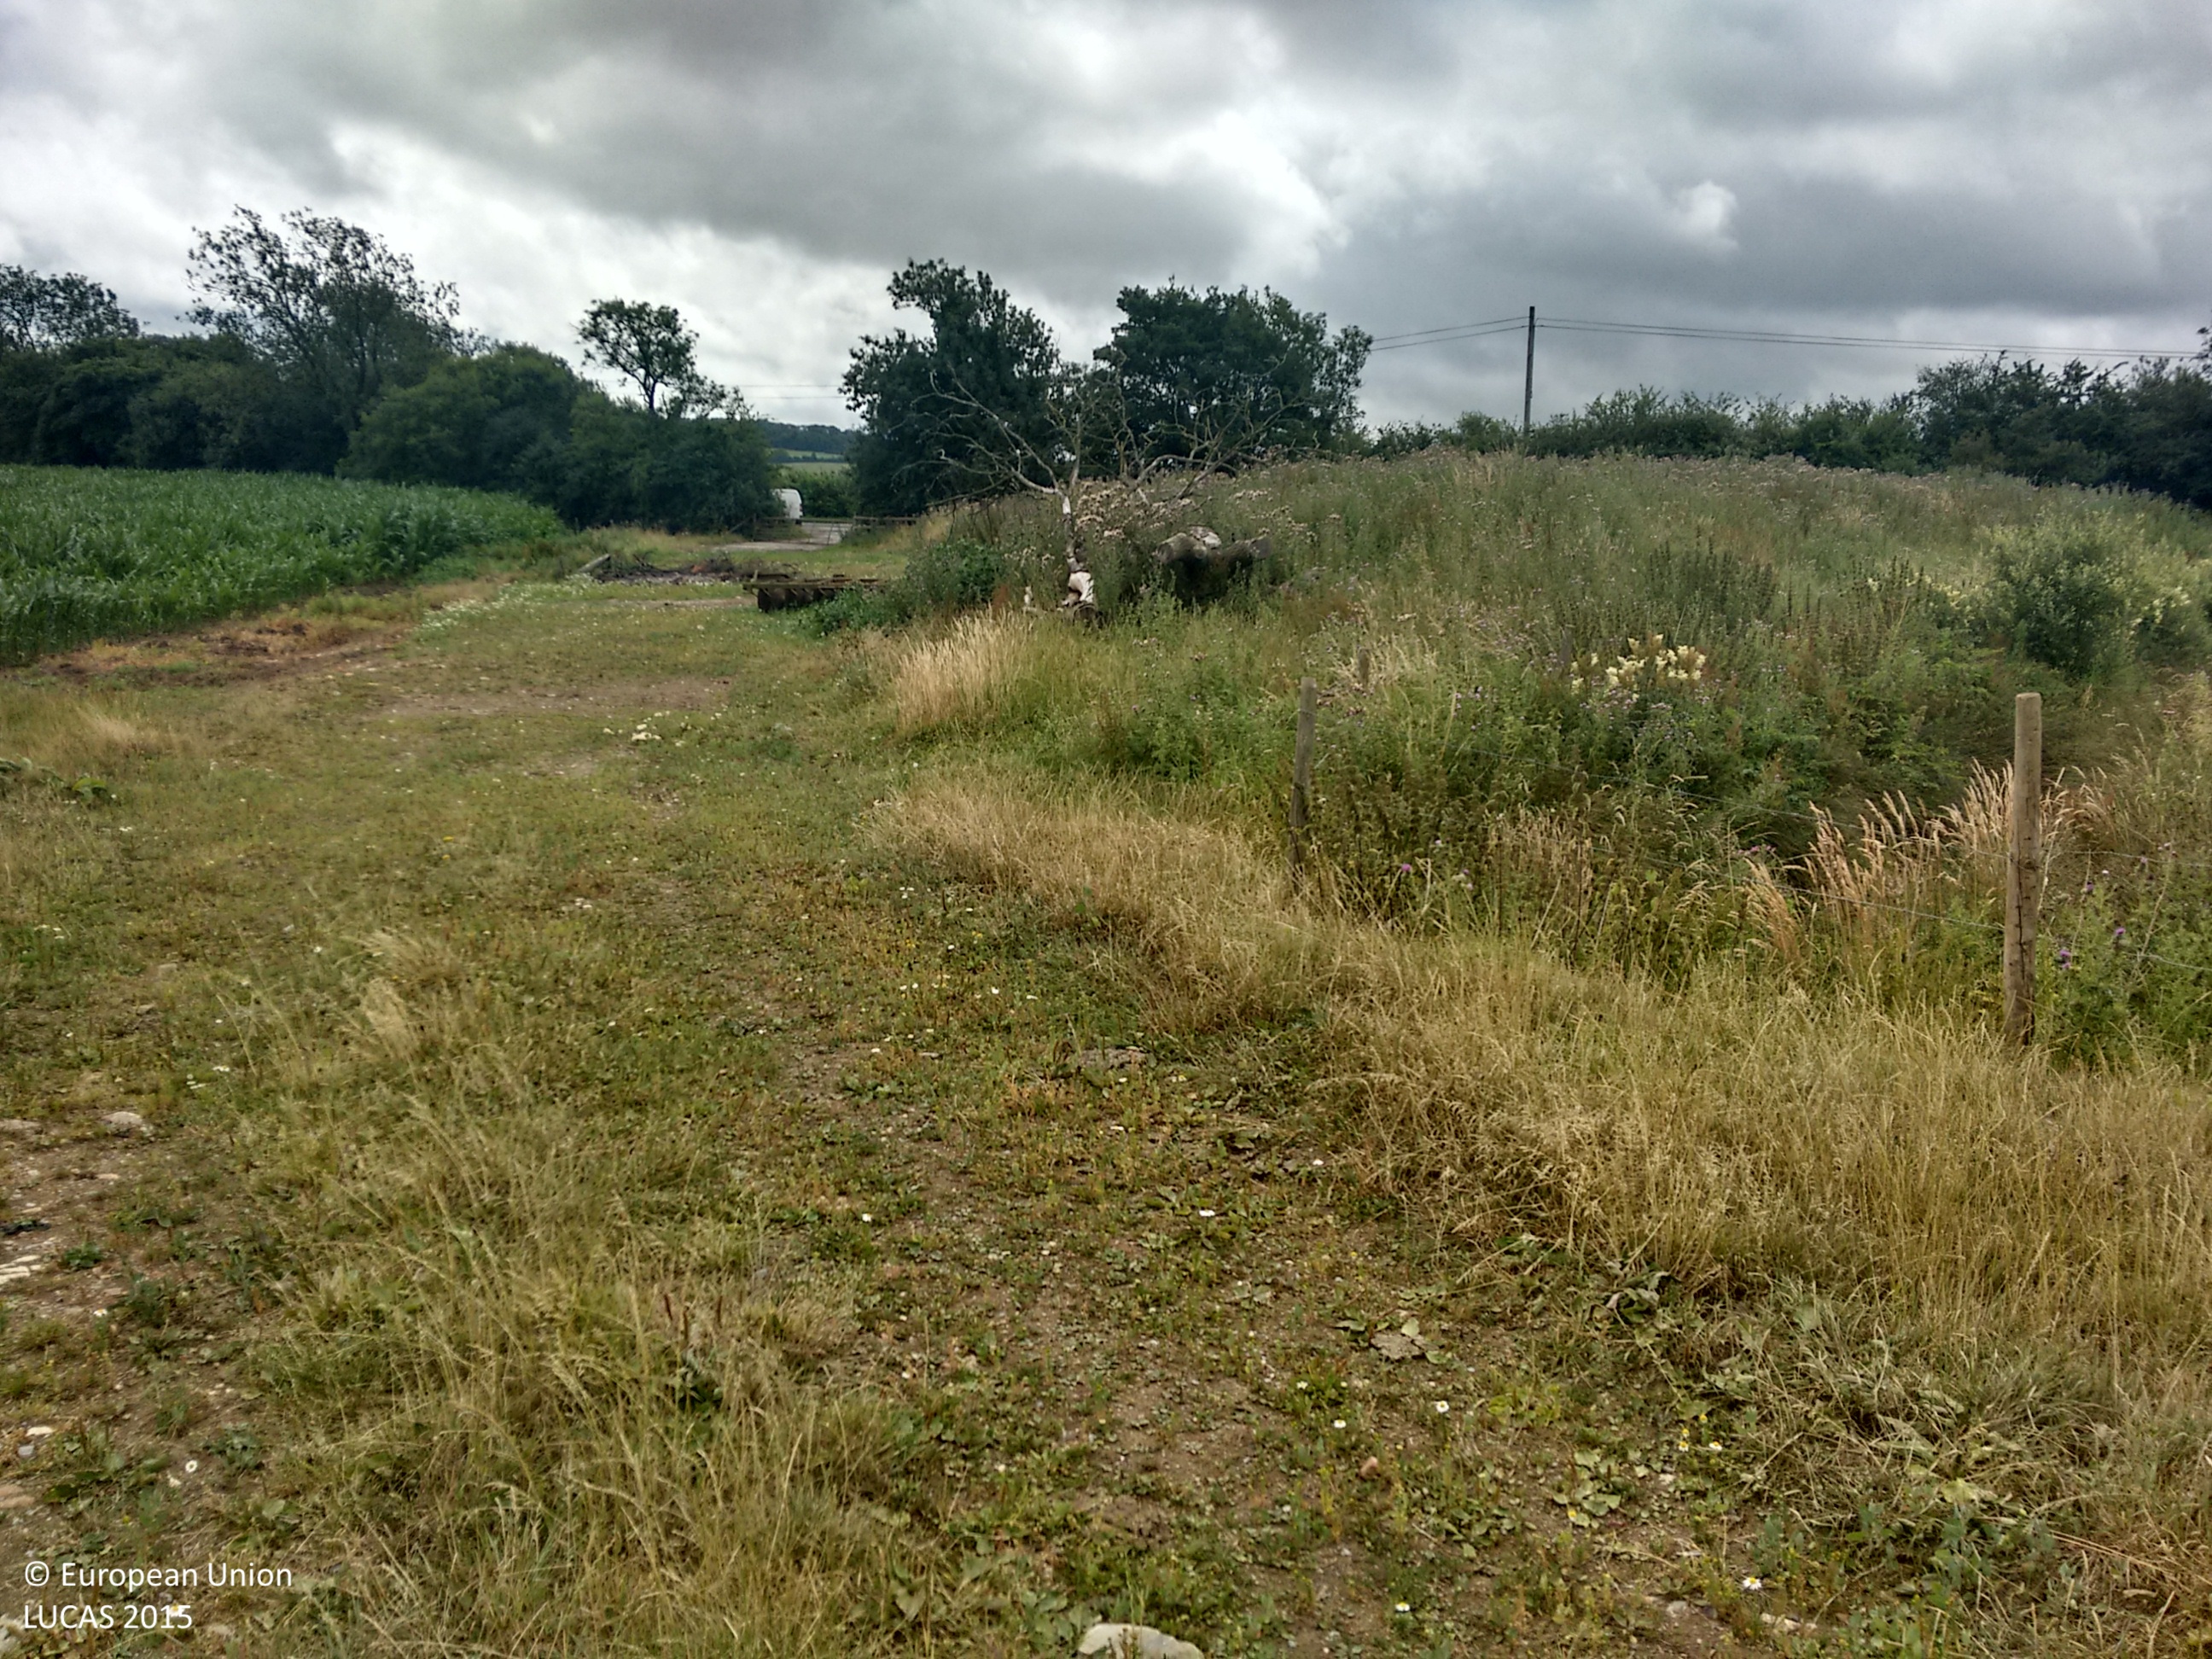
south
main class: Grassland
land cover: Grassland without tree/shrub cover
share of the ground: > 75 %
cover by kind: herbaceous plants 100 %
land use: Agriculture (excluding fallow land and kitchen gardens)
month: July
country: GB
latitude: 51.5076
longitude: -2.3833
